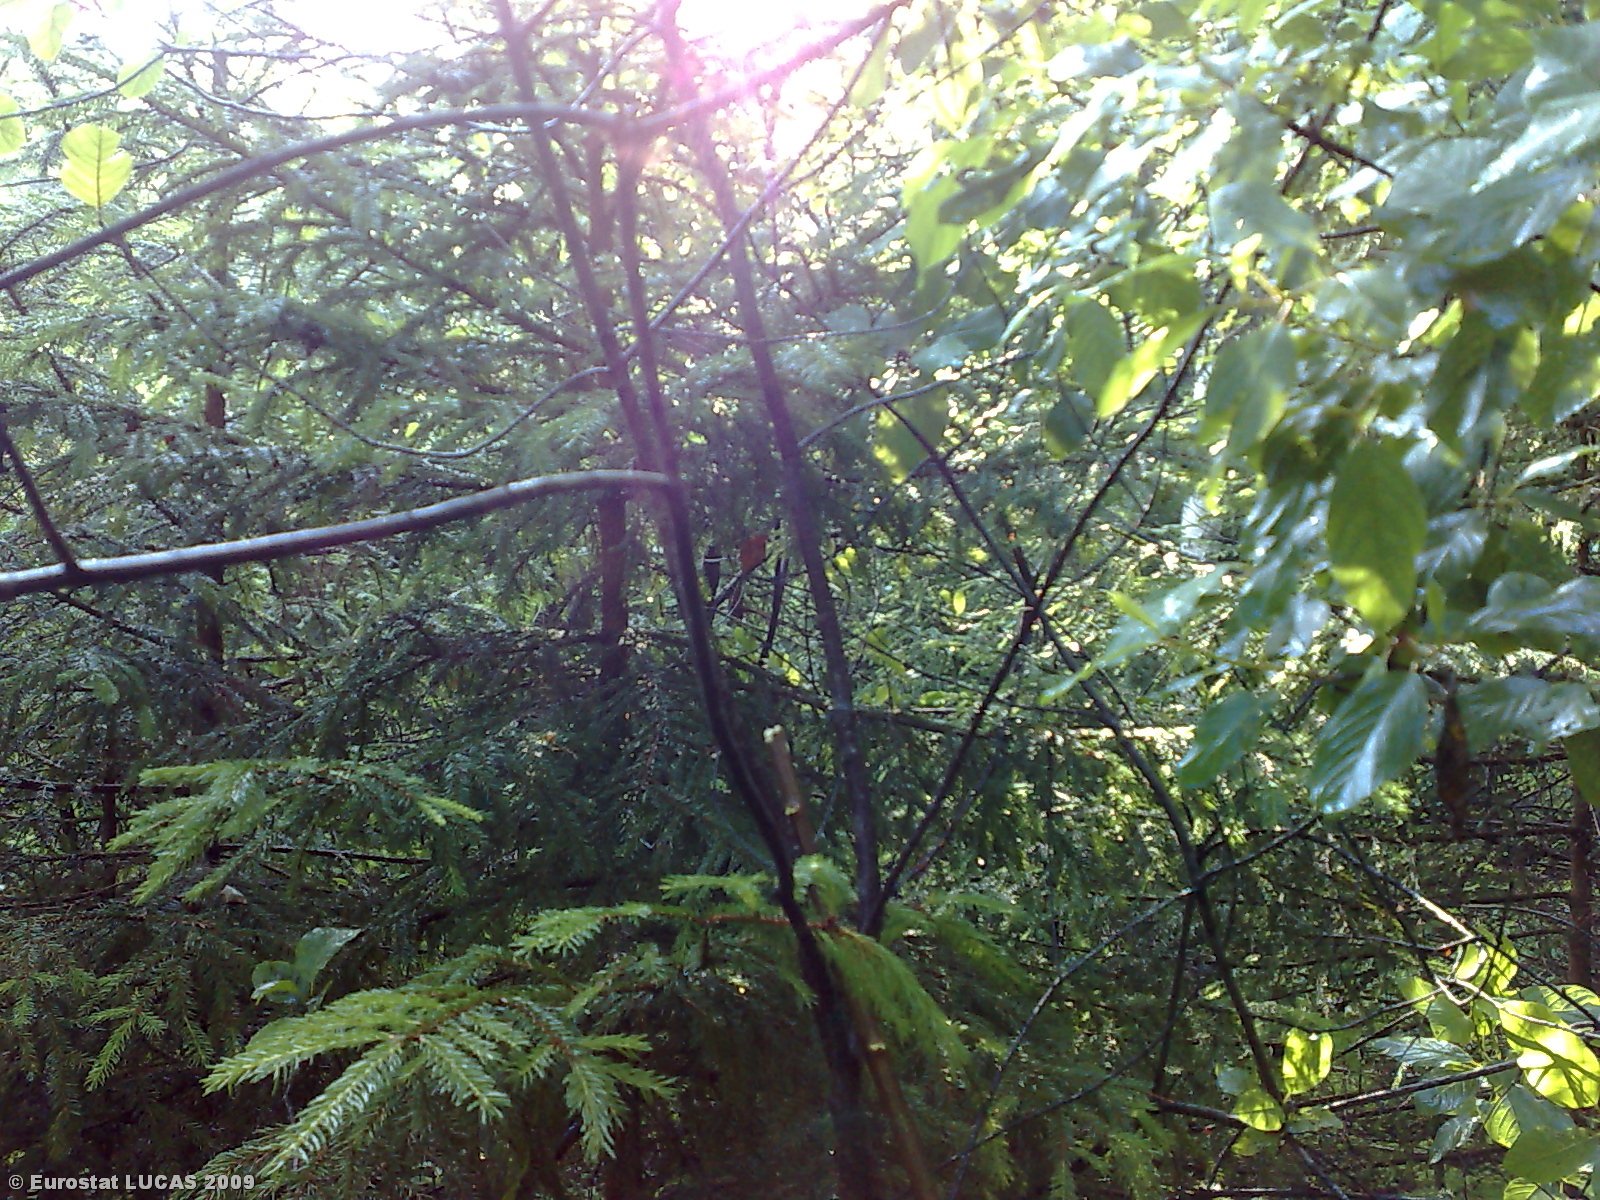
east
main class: Woodland
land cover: Mixed woodland
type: hemiboreal forest and nemoral coniferous forest and mixed broadleaved-coniferous forest
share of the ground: 50 - 75 %
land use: Forestry
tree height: > 5 m
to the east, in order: Mixed woodland; Broadleaved woodland; Shrubland with sparse tree cover; Broadleaved woodland; Shrubland with sparse tree cover
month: July
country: LT
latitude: 55.6853
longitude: 22.8383
